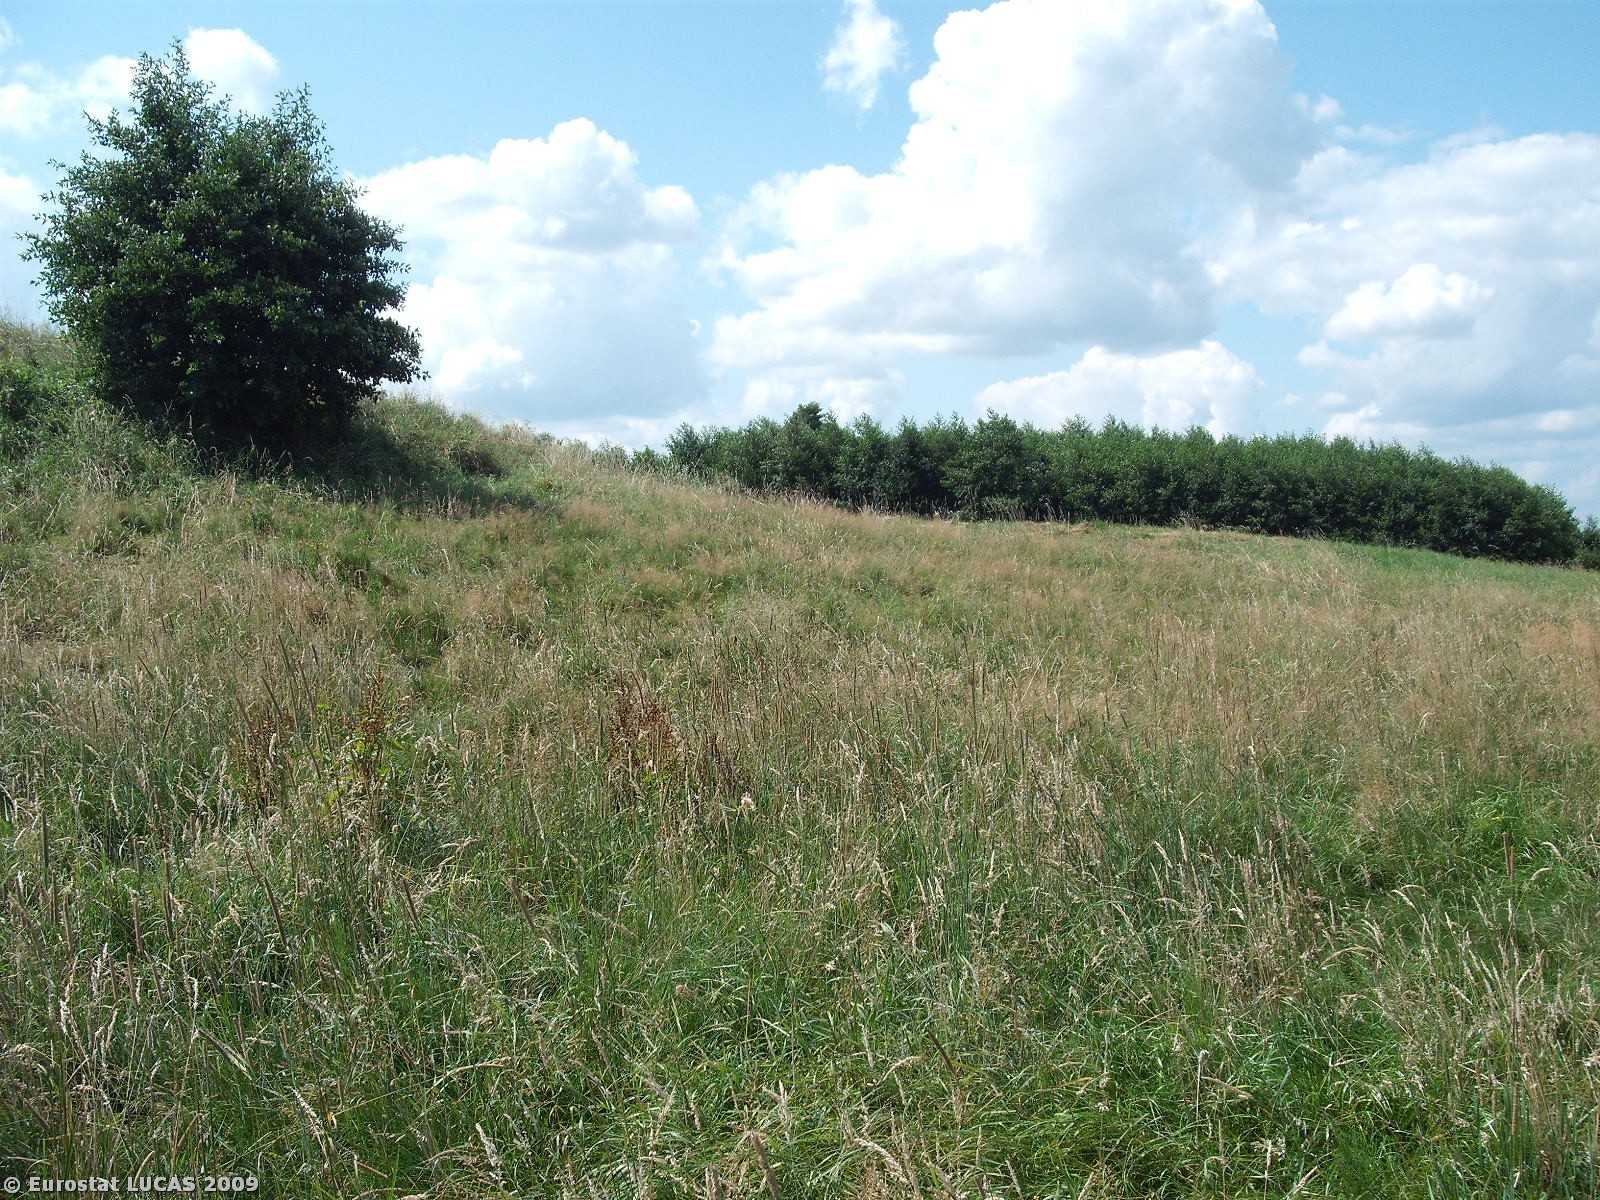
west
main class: Grassland
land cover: Grassland without tree/shrub cover
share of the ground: > 75 %
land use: Agriculture (excluding fallow land and kitchen gardens)
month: July
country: PL
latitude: 49.9979
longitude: 22.0415
